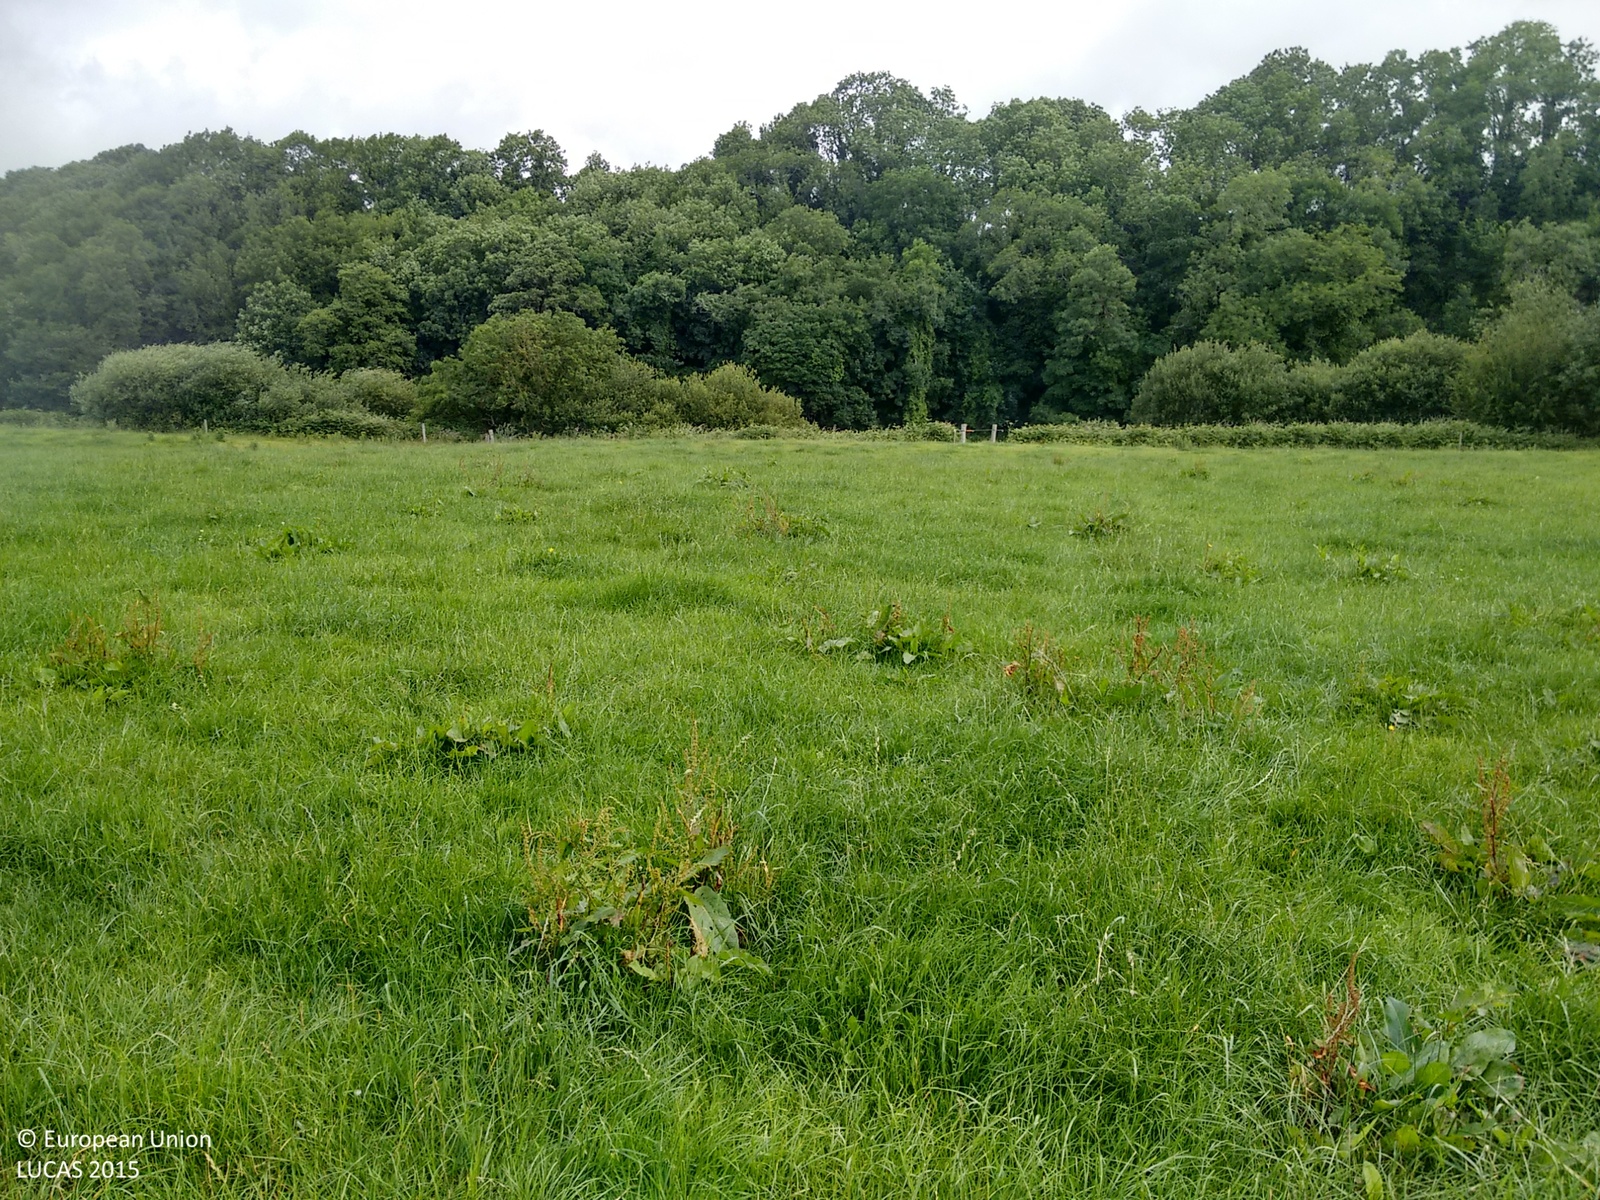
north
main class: Grassland
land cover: Grassland without tree/shrub cover
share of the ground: > 75 %
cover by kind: herbaceous plants 100 %
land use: Agriculture (excluding fallow land and kitchen gardens)
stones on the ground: < 10 %
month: July
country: IE
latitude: 52.1506
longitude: -8.4462
